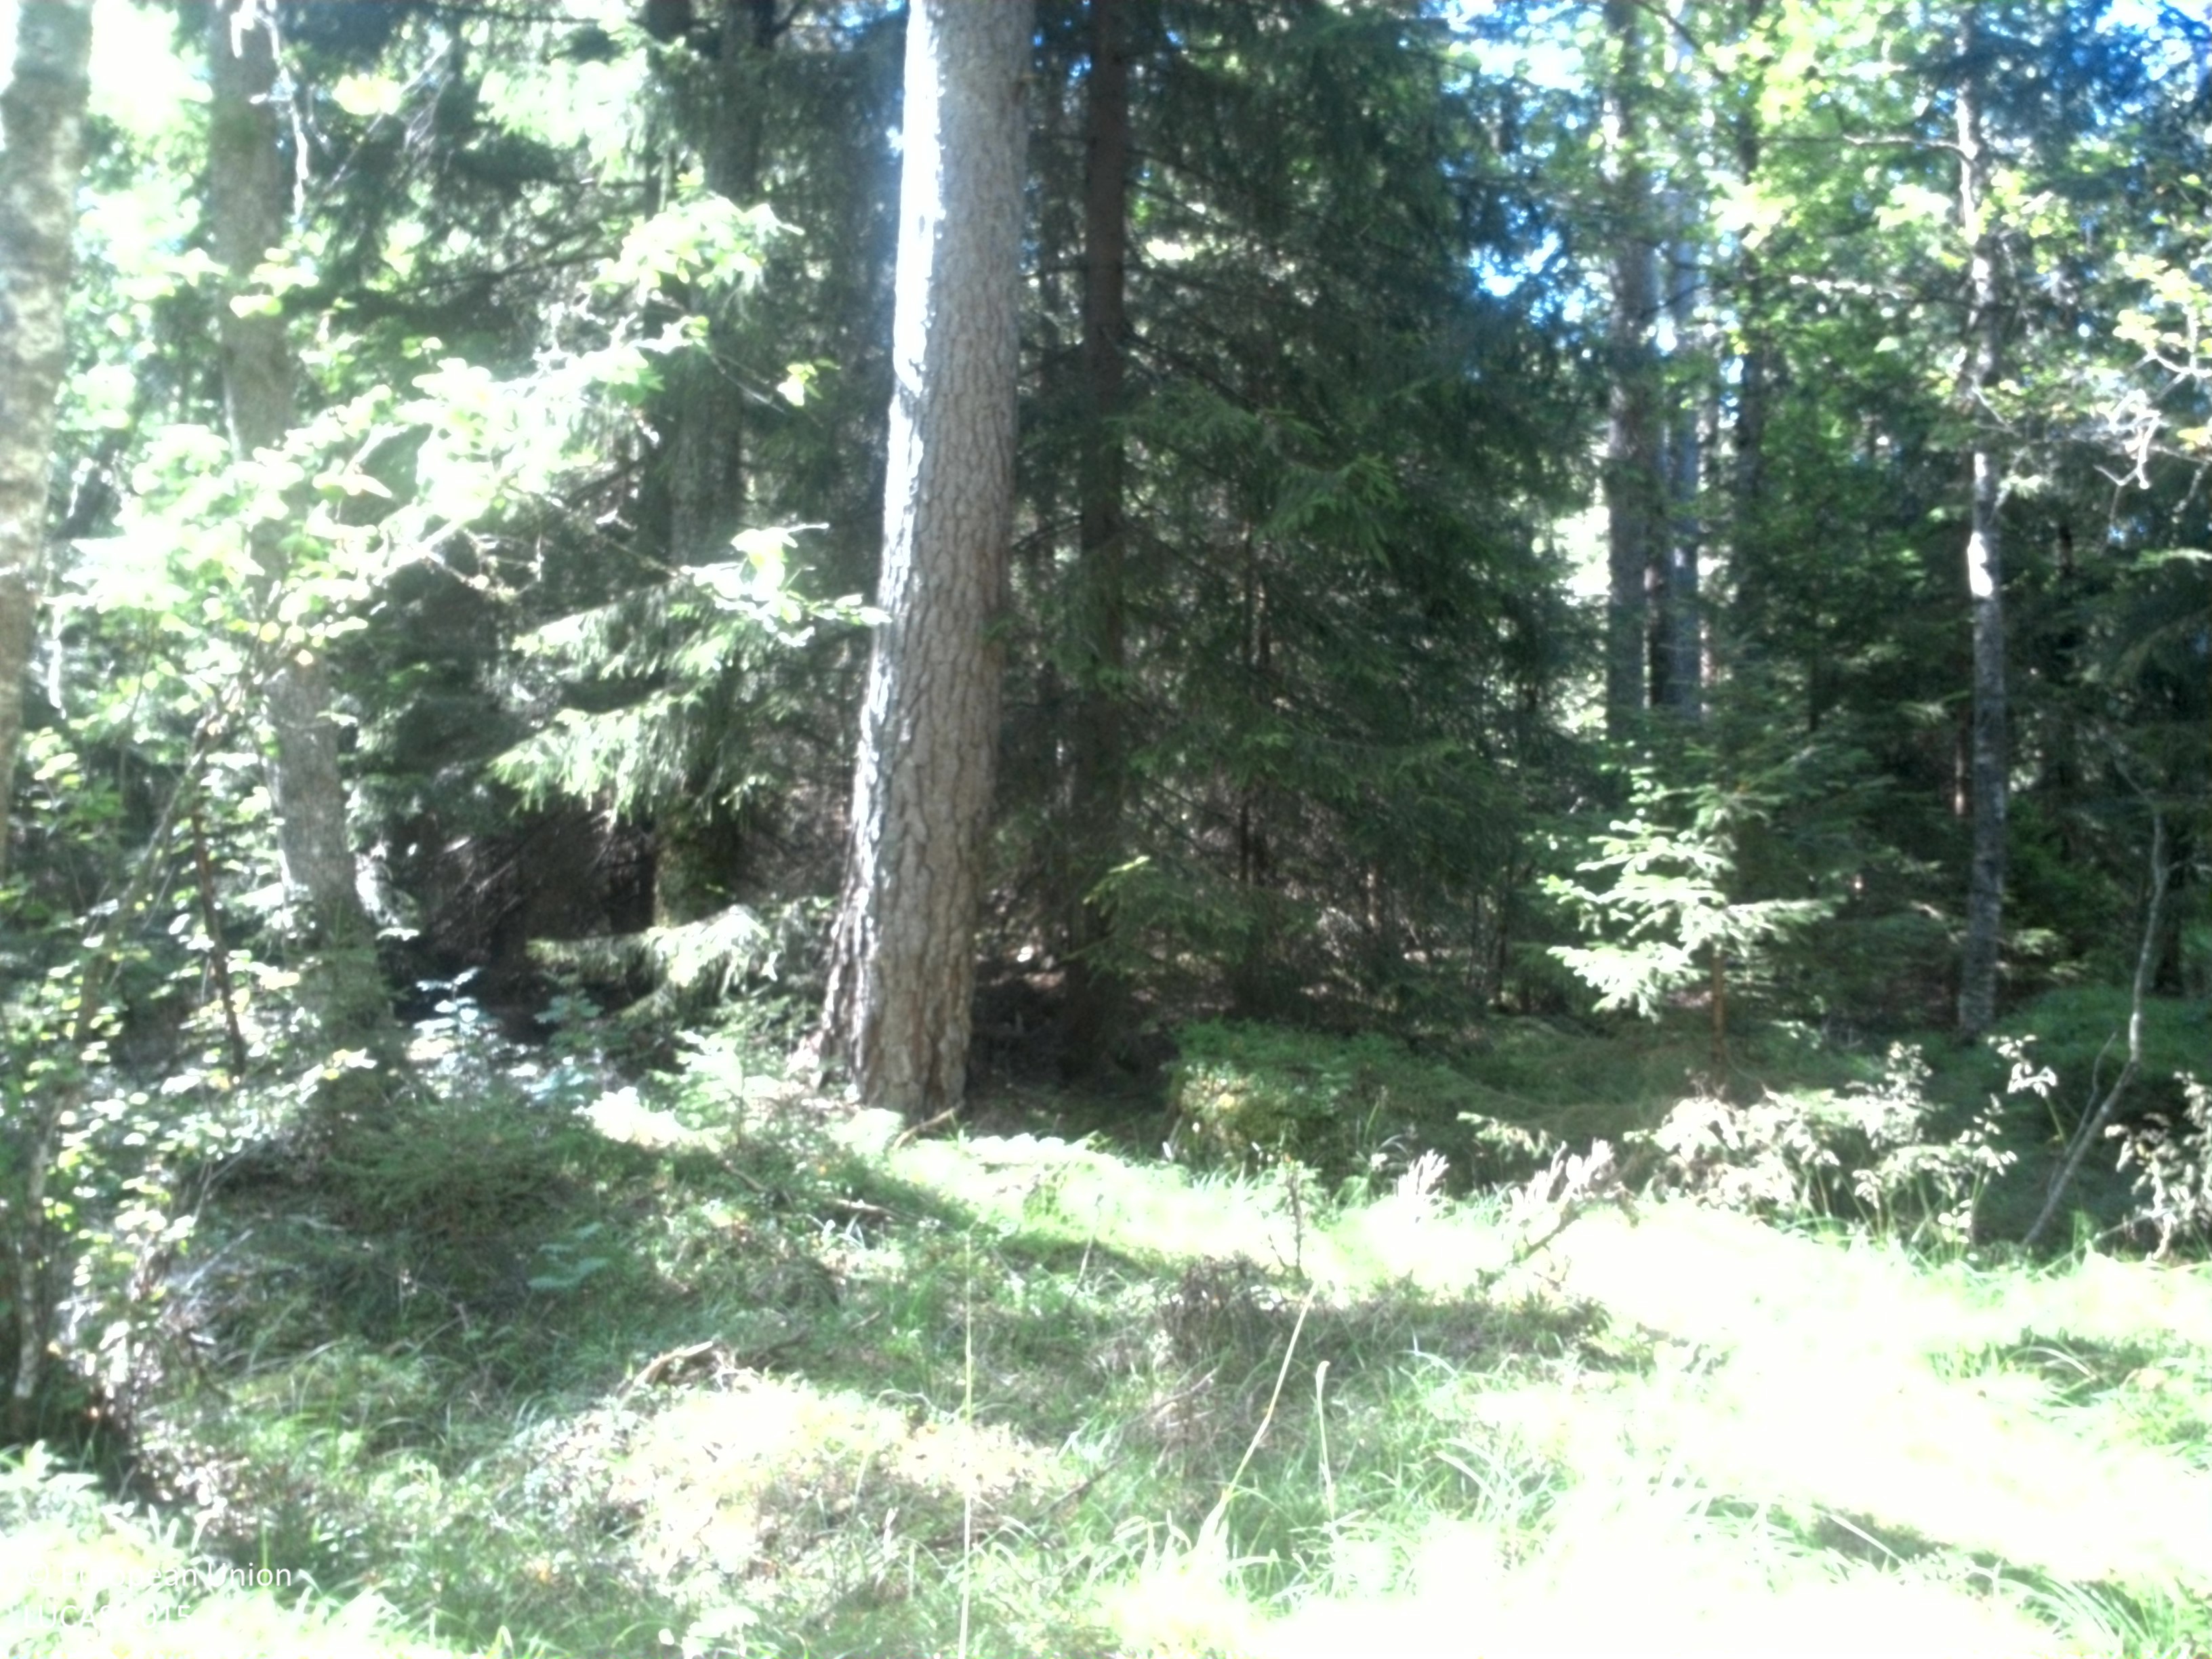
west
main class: Woodland
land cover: Pine dominated mixed woodland
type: boreal forest
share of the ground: 50 - 75 %
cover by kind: coniferous forest trees 30 %, herbaceous plants 25 %, broadleaved forest trees 20 %, lichens and mosses 15 %, shrubs 10 %
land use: Forestry
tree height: > 5 m
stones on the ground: > 50 %
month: August
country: SE
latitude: 58.0718
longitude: 13.2668
